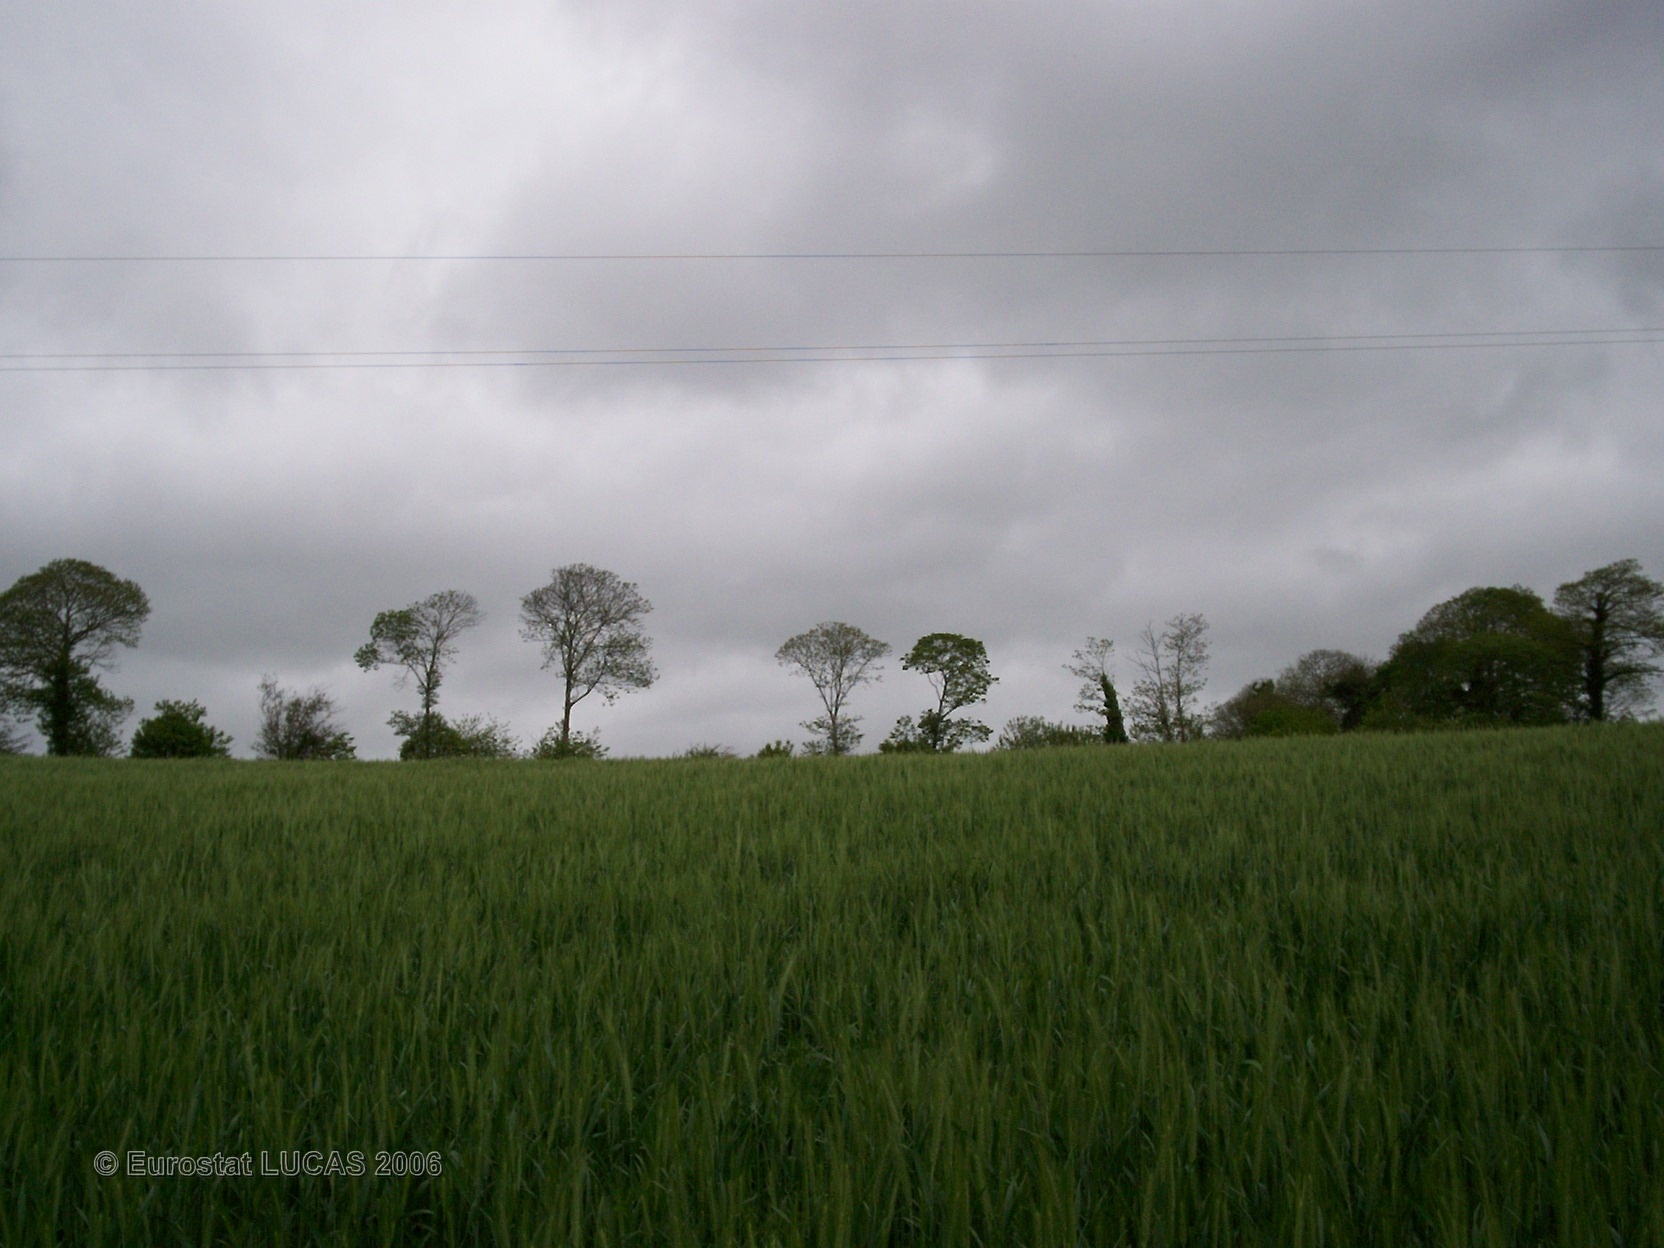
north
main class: Cropland
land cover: Common wheat
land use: Agriculture (excluding fallow land and kitchen gardens)
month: May
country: FR
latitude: 47.9242
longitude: -3.8814
